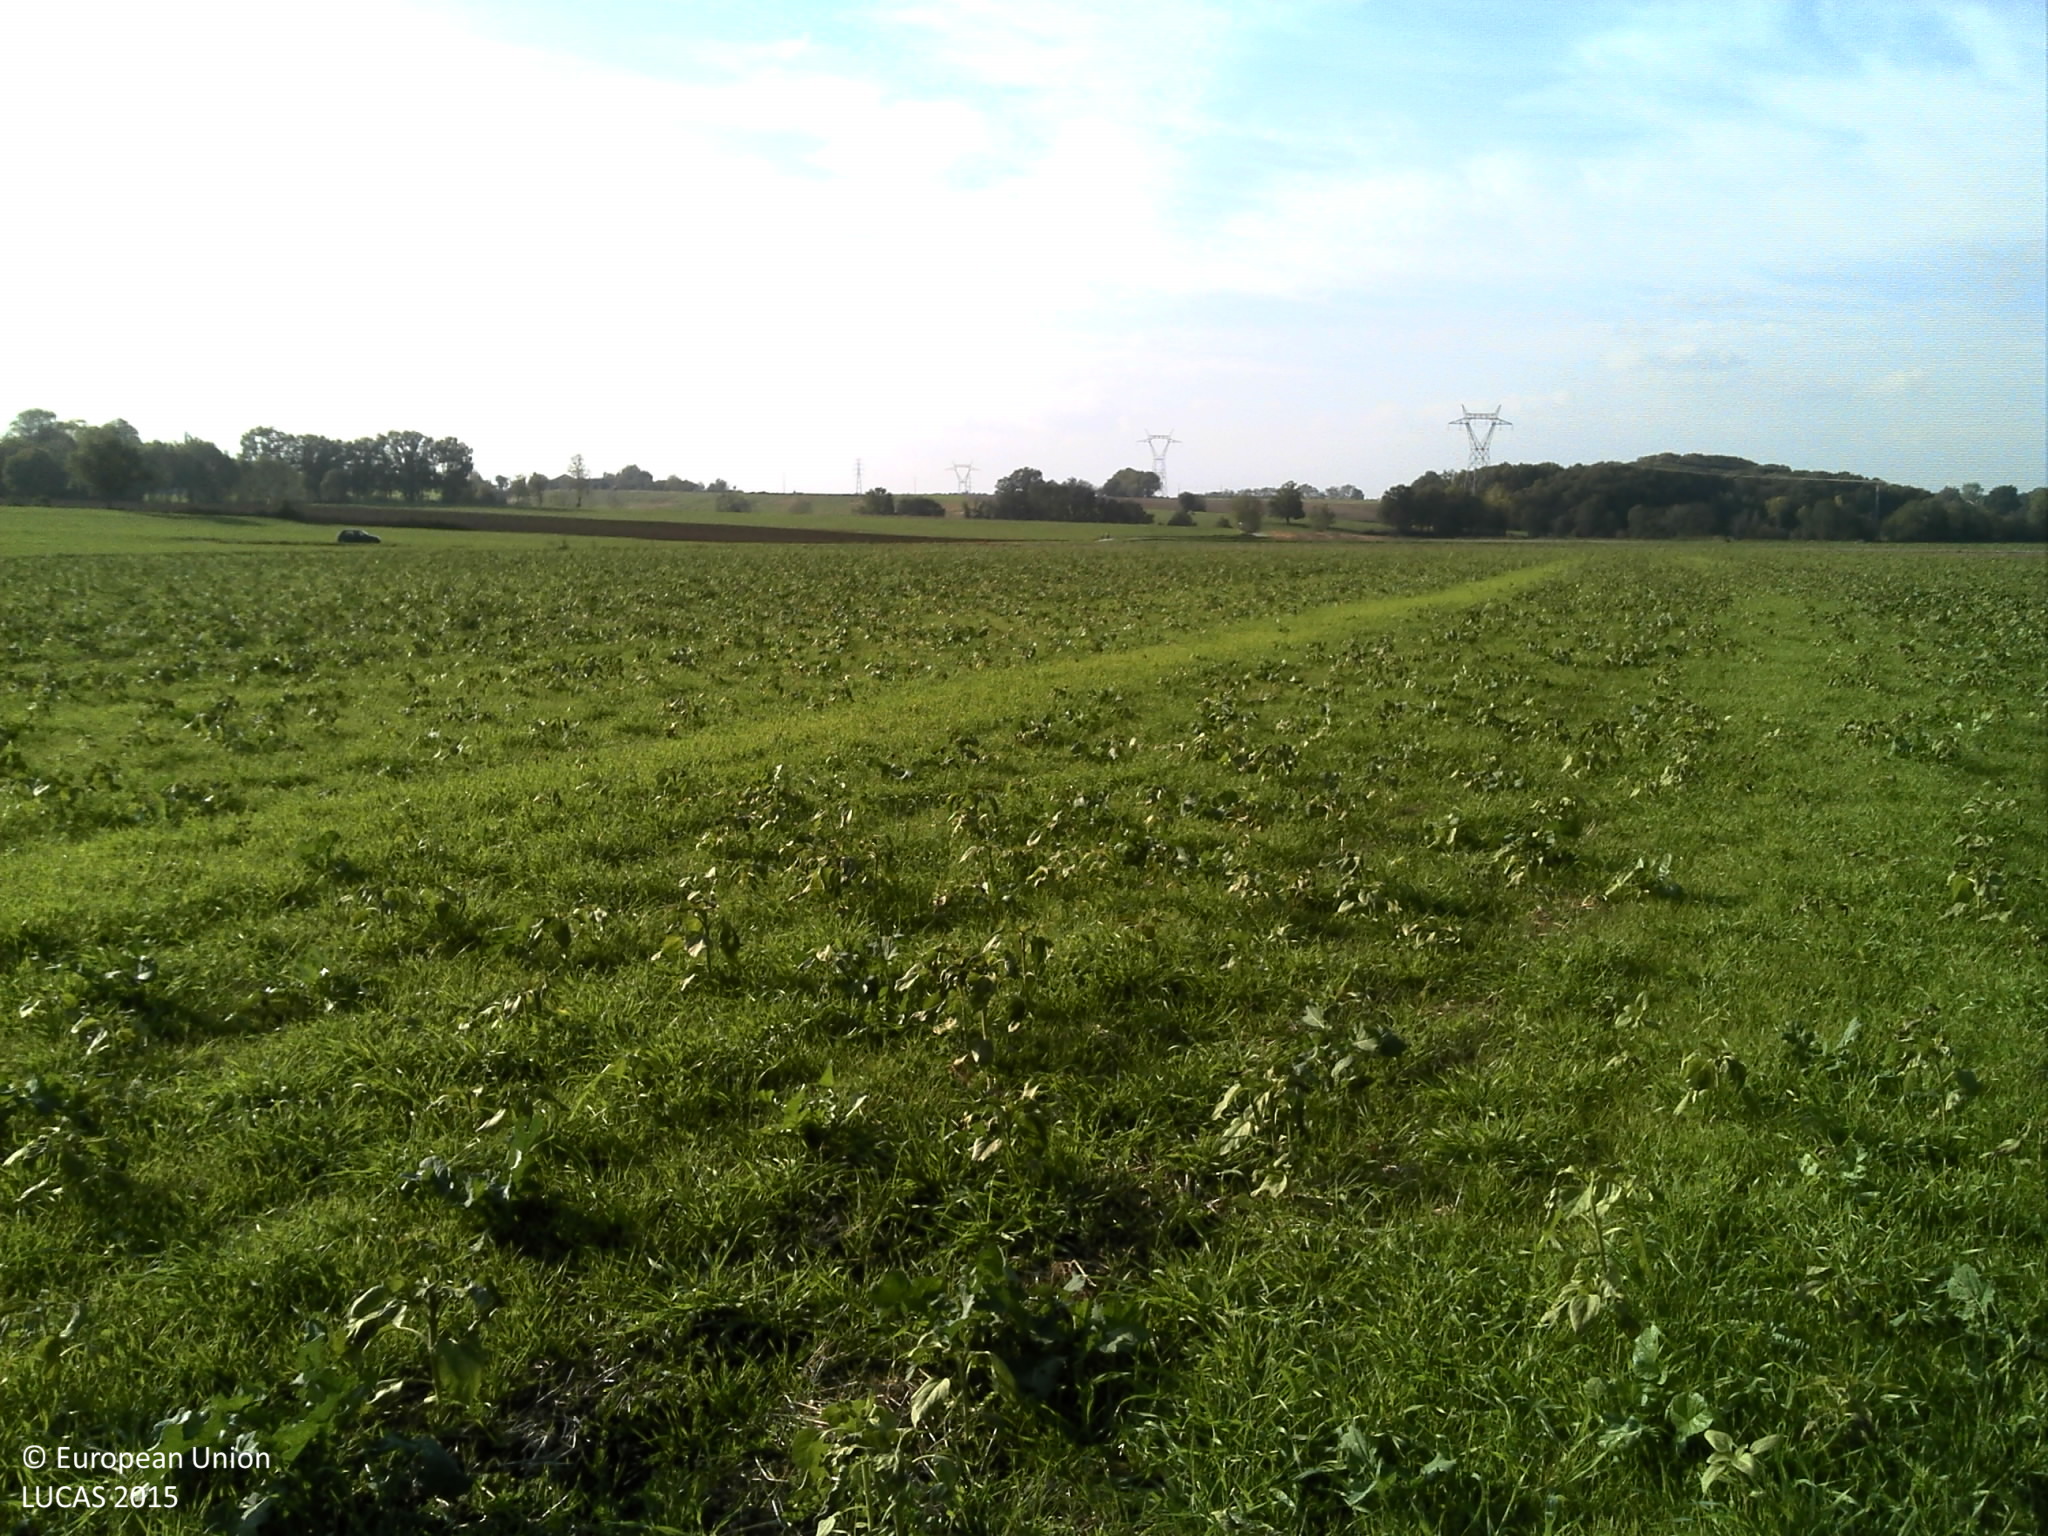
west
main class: Cropland
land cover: Sunflower
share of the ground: 10 - 25 %
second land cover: Spontaneously vegetated surfaces
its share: > 75 %
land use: Agriculture (excluding fallow land and kitchen gardens)
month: October
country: FR
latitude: 46.2500
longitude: 5.3464
